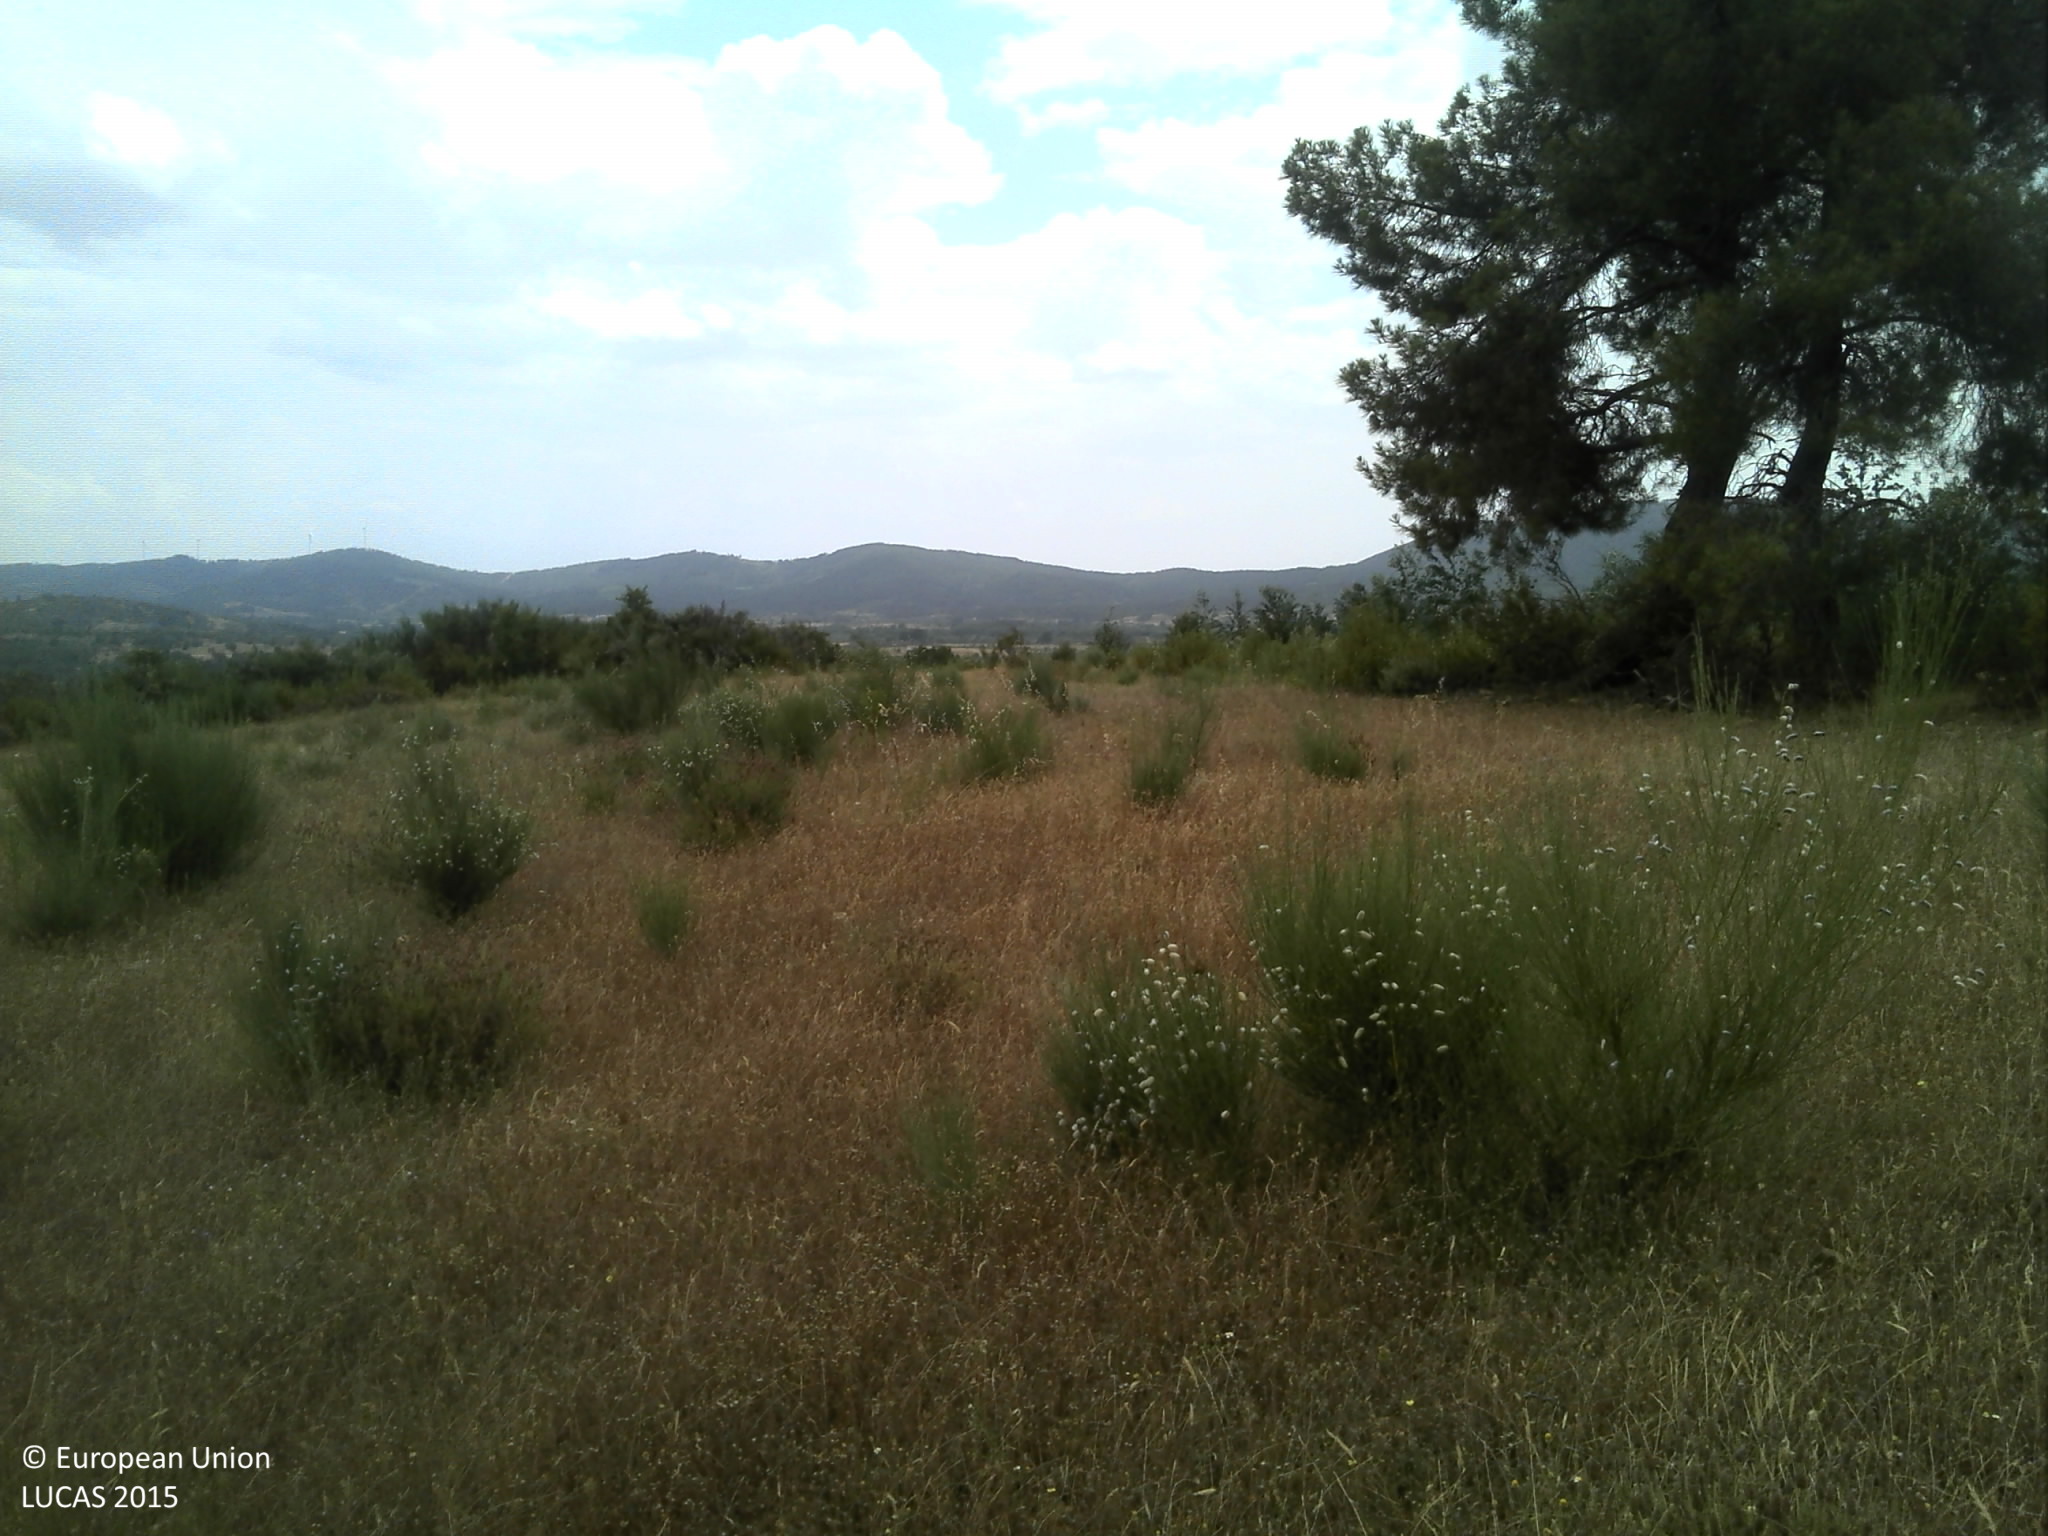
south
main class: Grassland
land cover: Grassland without tree/shrub cover
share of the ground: 50 - 75 %
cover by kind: herbaceous plants 65 %, unconsolidated bare surface 25 %, shrubs 5 %
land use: Agriculture (excluding fallow land and kitchen gardens)
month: June
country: PT
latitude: 40.2607
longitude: -7.2319
